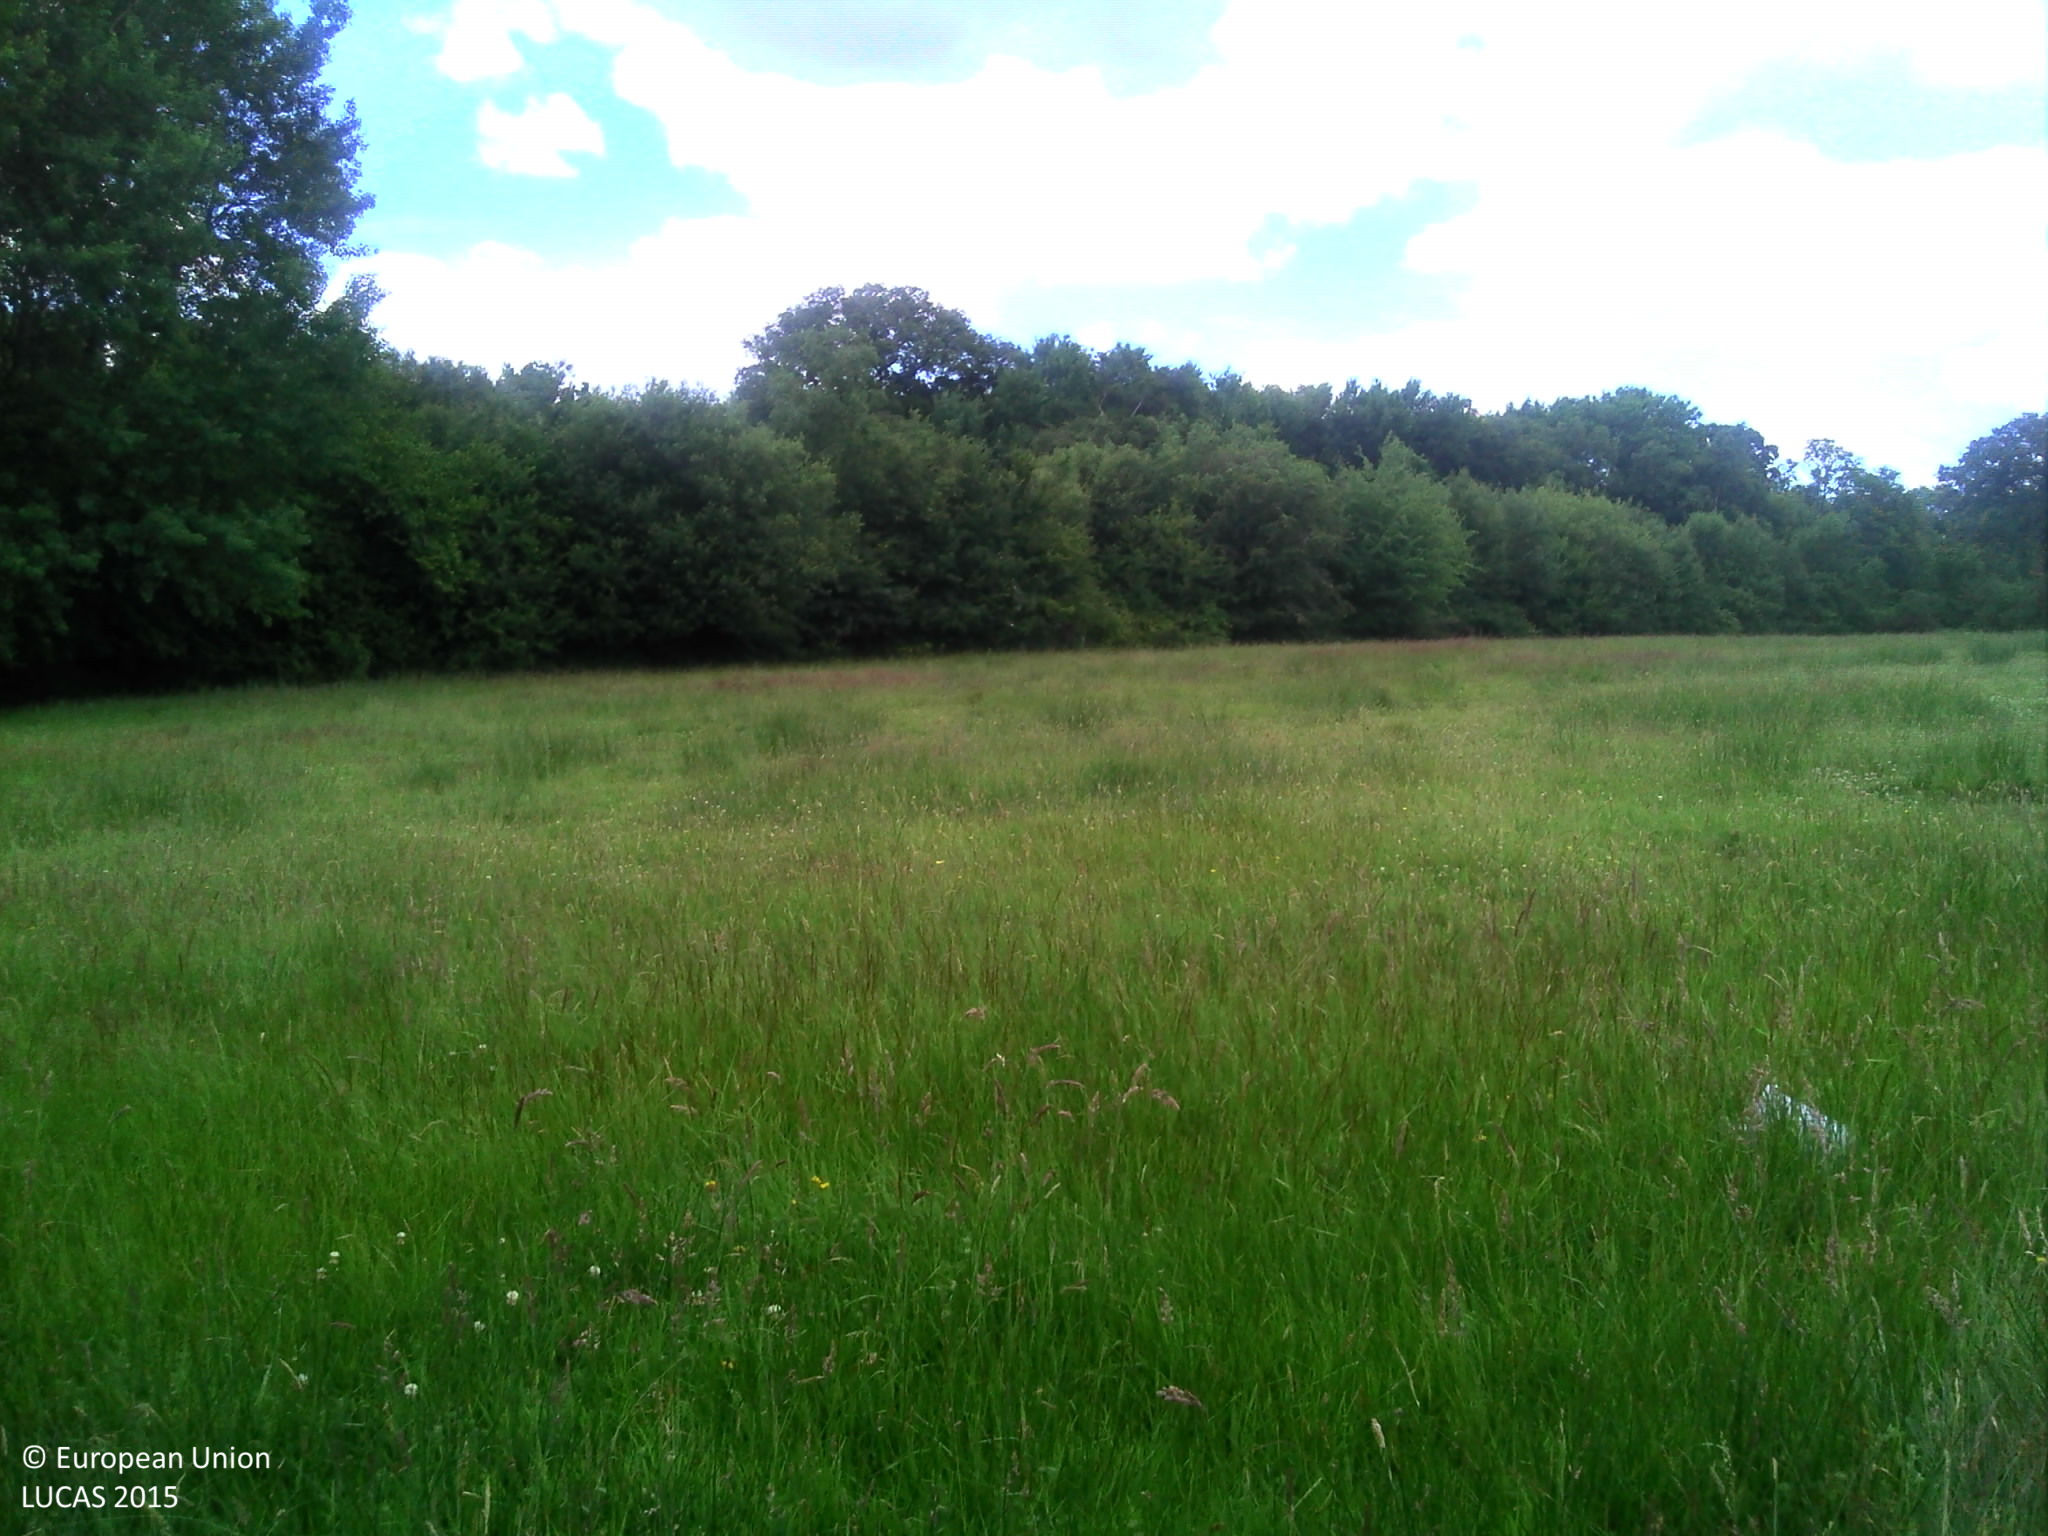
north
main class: Grassland
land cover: Grassland without tree/shrub cover
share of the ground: > 75 %
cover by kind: herbaceous plants 100 %
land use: Agriculture (excluding fallow land and kitchen gardens)
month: June
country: FR
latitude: 49.3982
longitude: -1.6955
